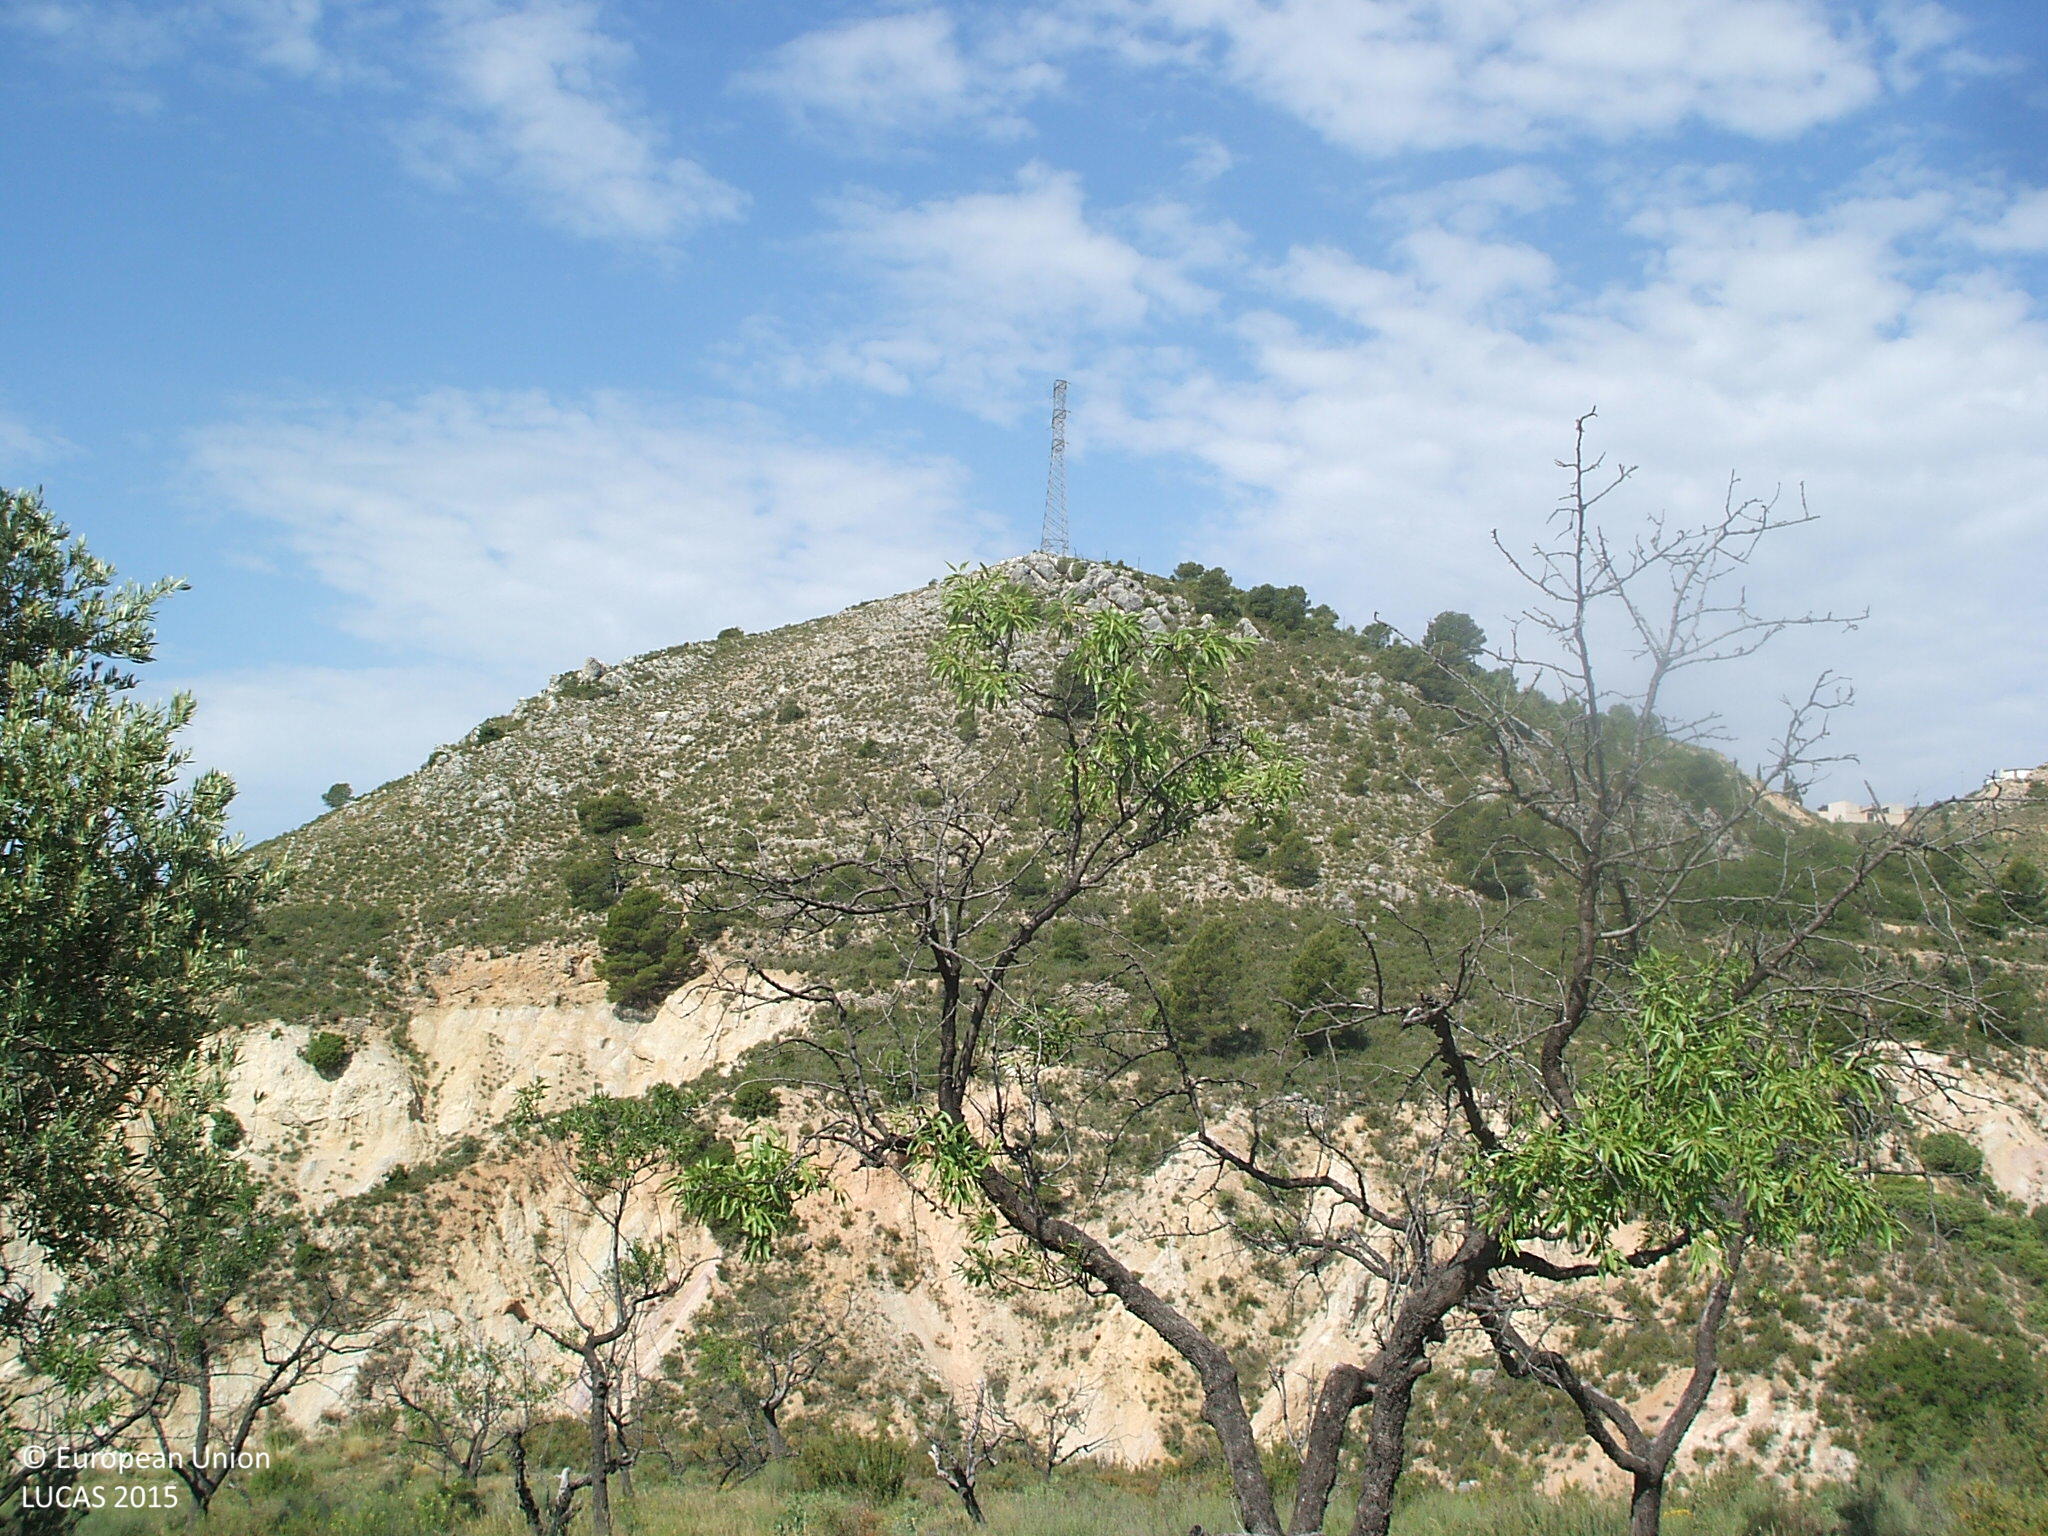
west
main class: Cropland
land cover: Nuts trees
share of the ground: 25 - 50 %
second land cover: Grassland without tree/shrub cover
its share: > 75 %
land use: Agriculture (excluding fallow land and kitchen gardens)
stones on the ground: > 50 %
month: June
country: ES
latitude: 40.7978
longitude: -0.3098
